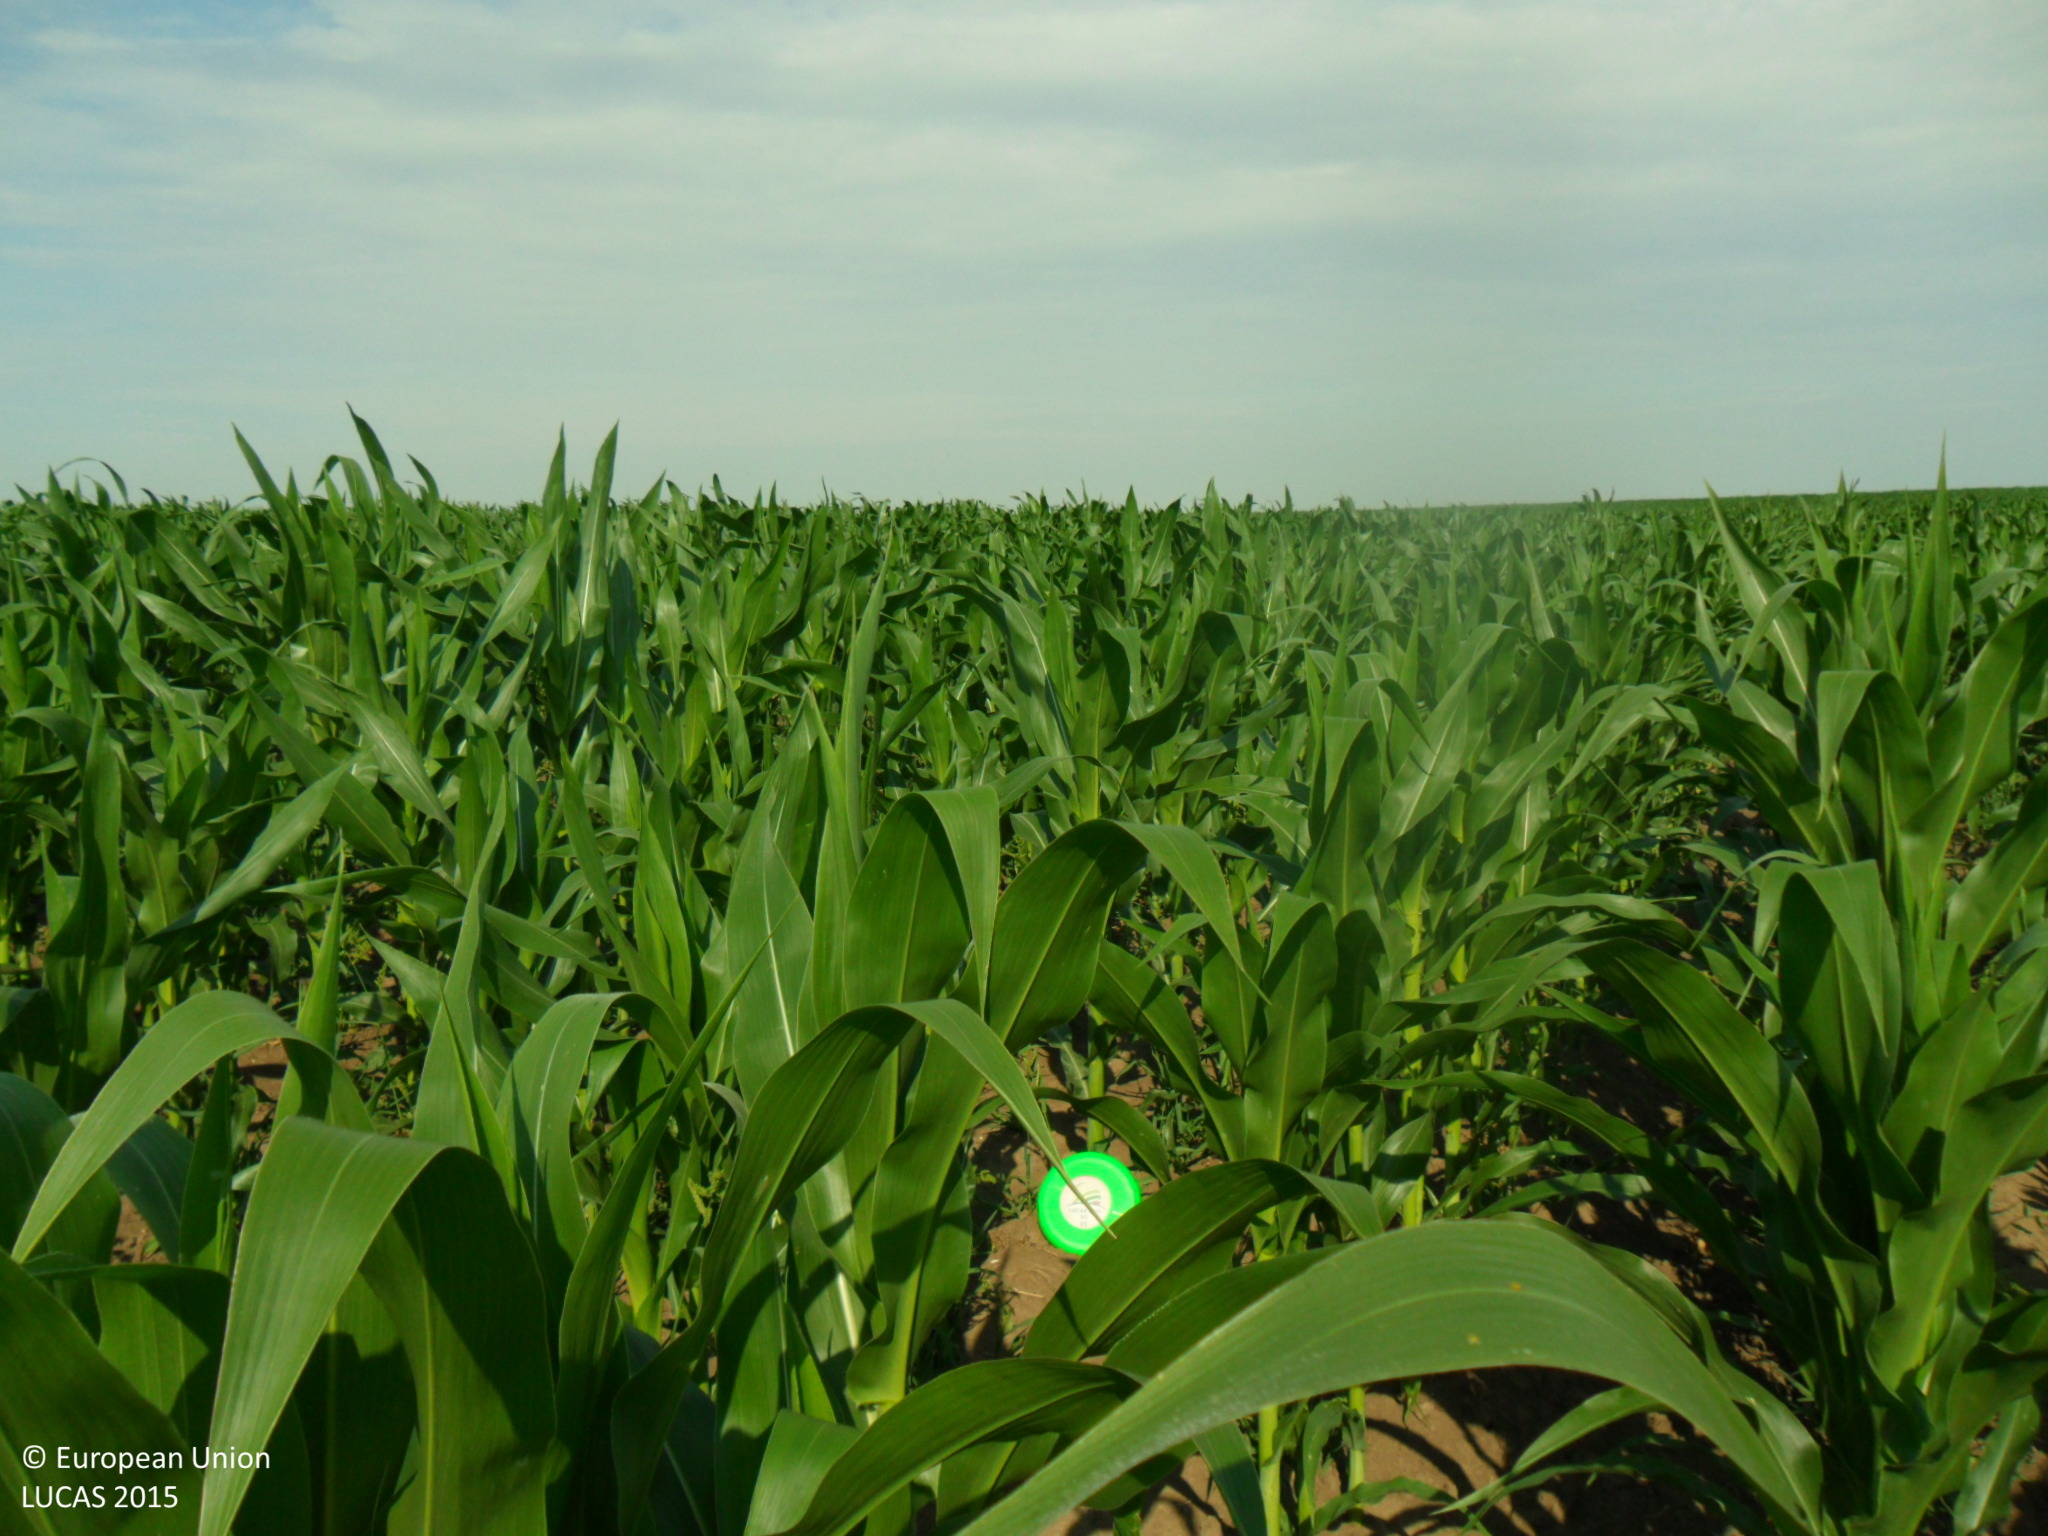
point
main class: Cropland
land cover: Maize
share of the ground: > 75 %
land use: Agriculture (excluding fallow land and kitchen gardens)
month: July
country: BG
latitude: 43.6417
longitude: 26.7359
